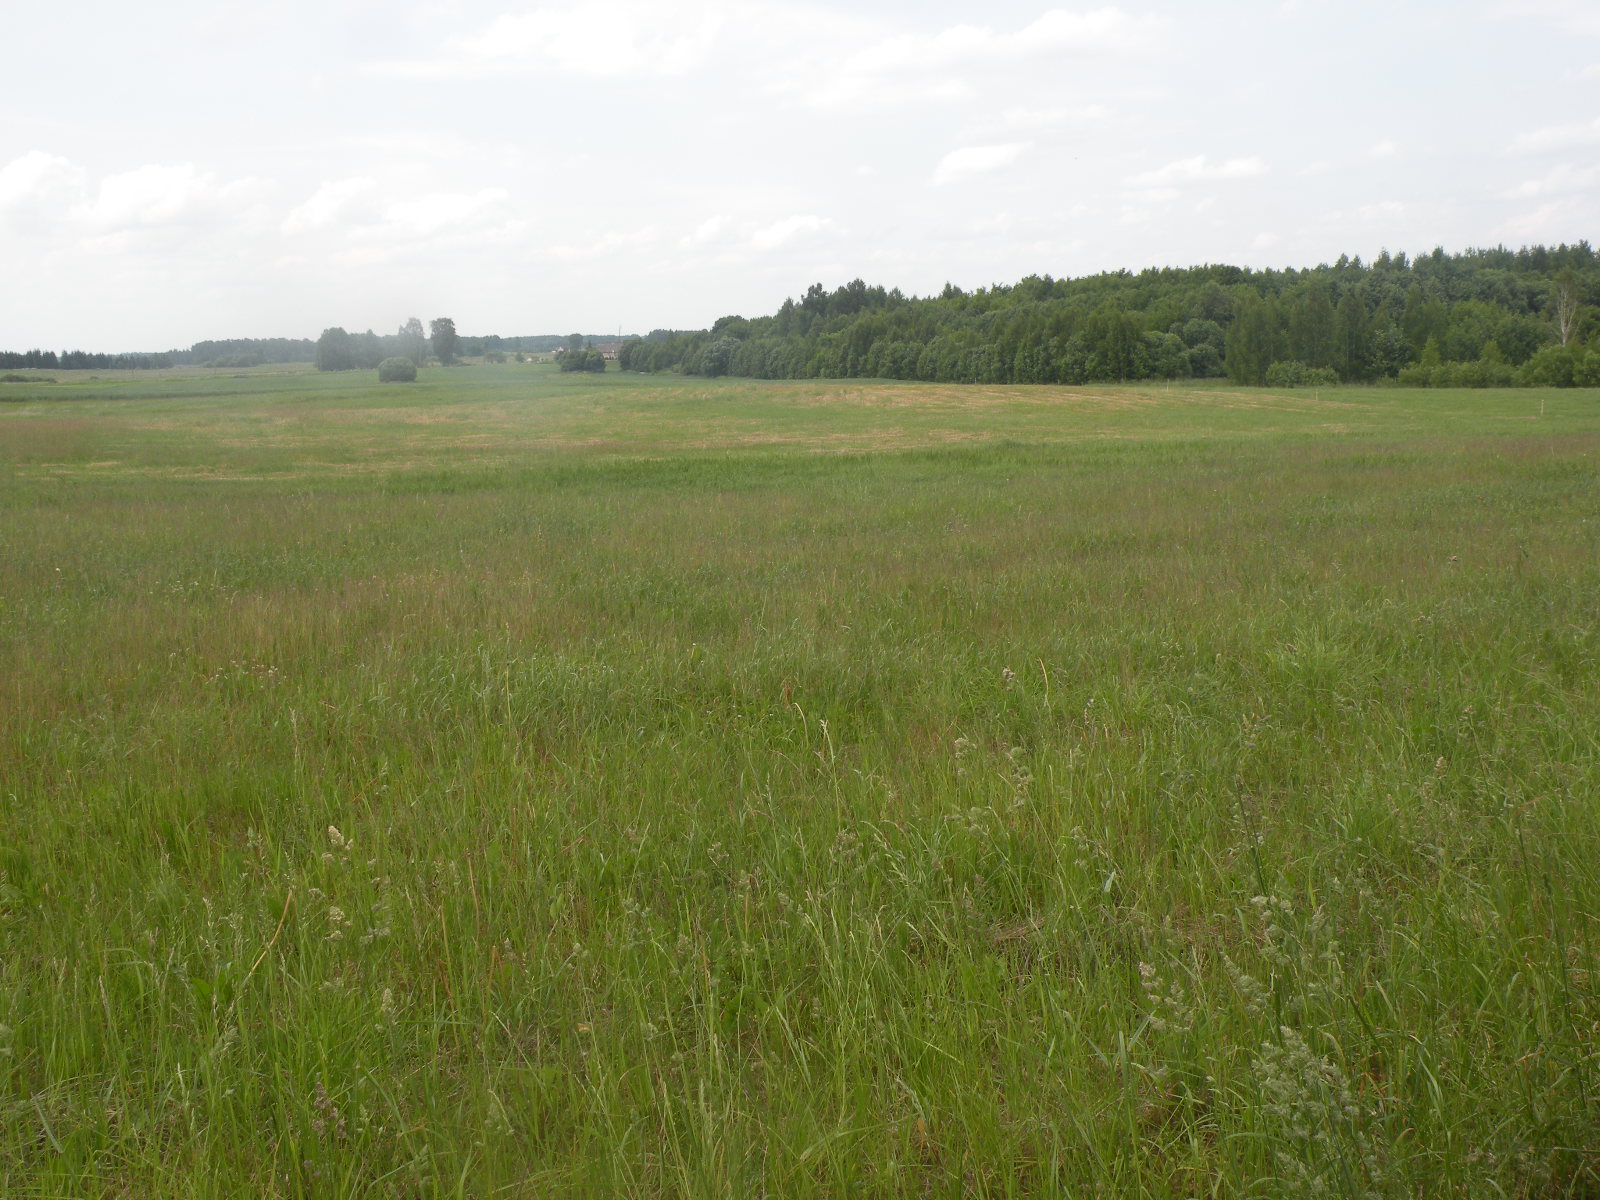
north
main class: Grassland
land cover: Grassland without tree/shrub cover
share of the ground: > 75 %
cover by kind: herbaceous plants 100 %
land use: Agriculture (excluding fallow land and kitchen gardens)
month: June
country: LV
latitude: 56.0516
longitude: 26.7432
